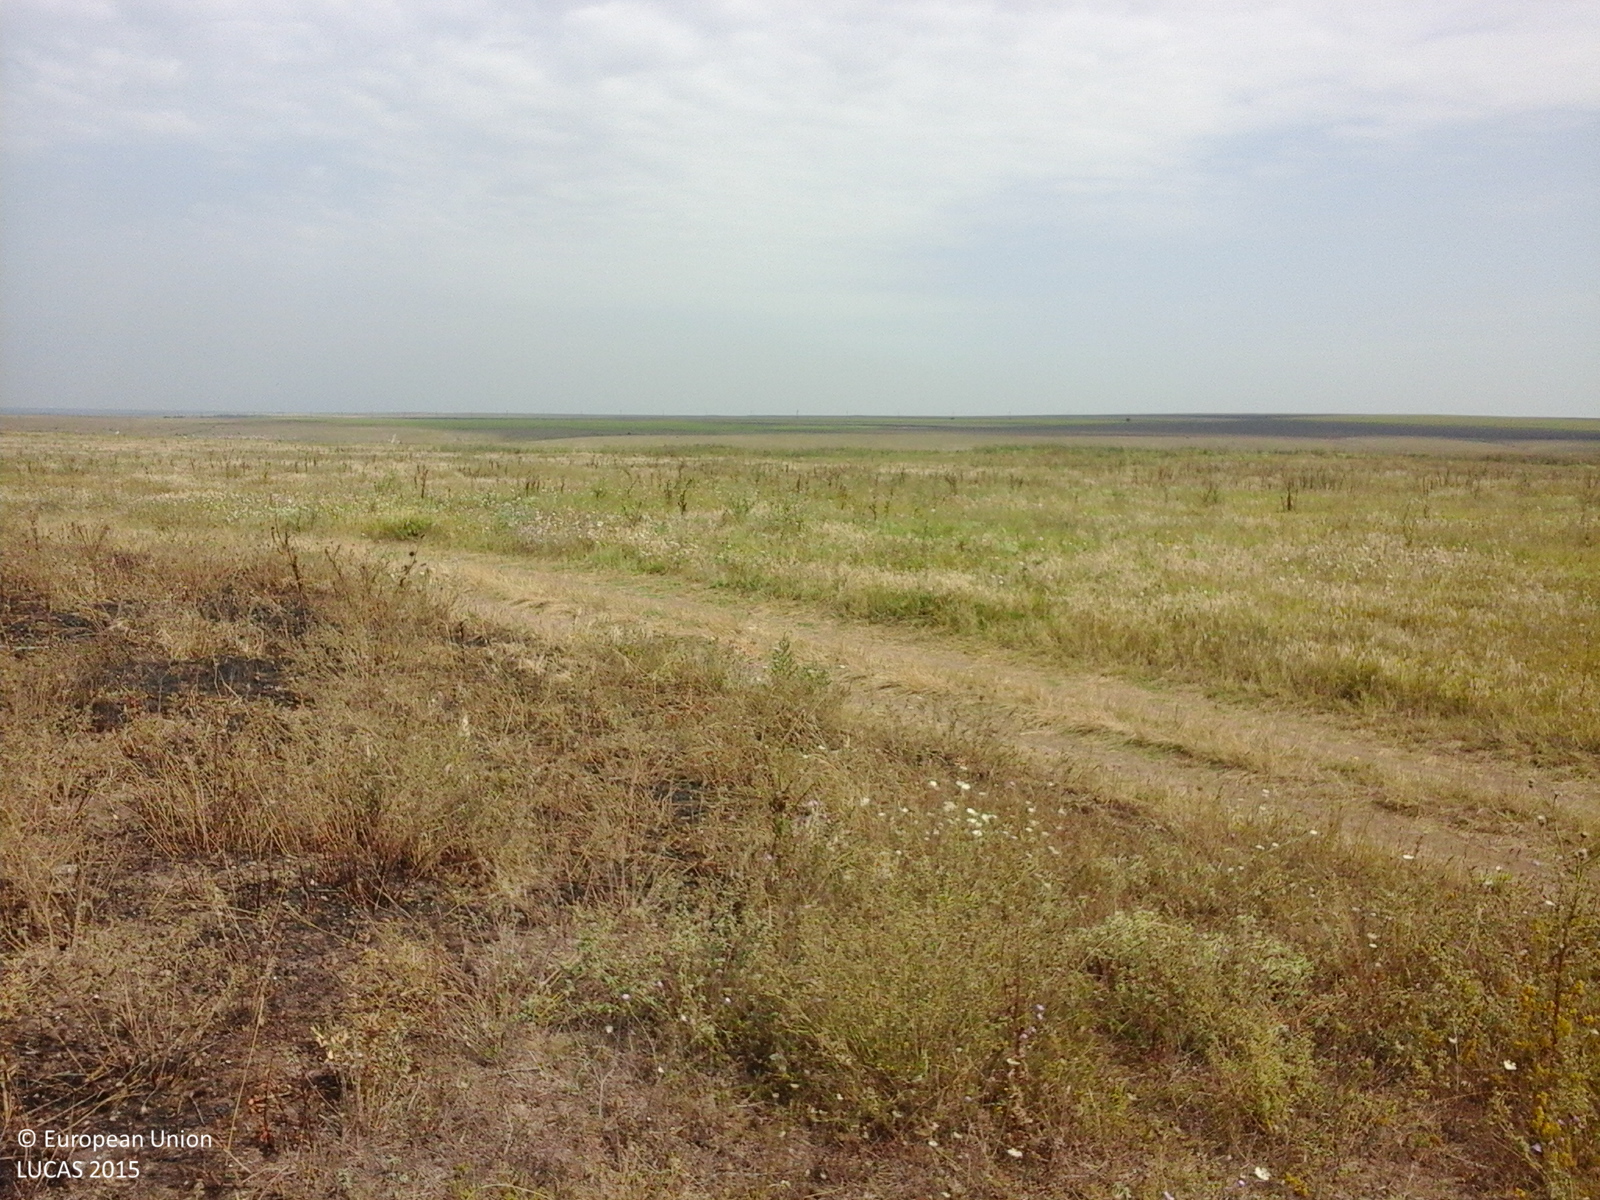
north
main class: Grassland
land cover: Spontaneously vegetated surfaces
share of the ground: > 75 %
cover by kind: herbaceous plants 70 %, consolidated bare surface 30 %
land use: Fallow land
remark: Burnt area
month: August
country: RO
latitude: 43.7660
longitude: 28.3585
